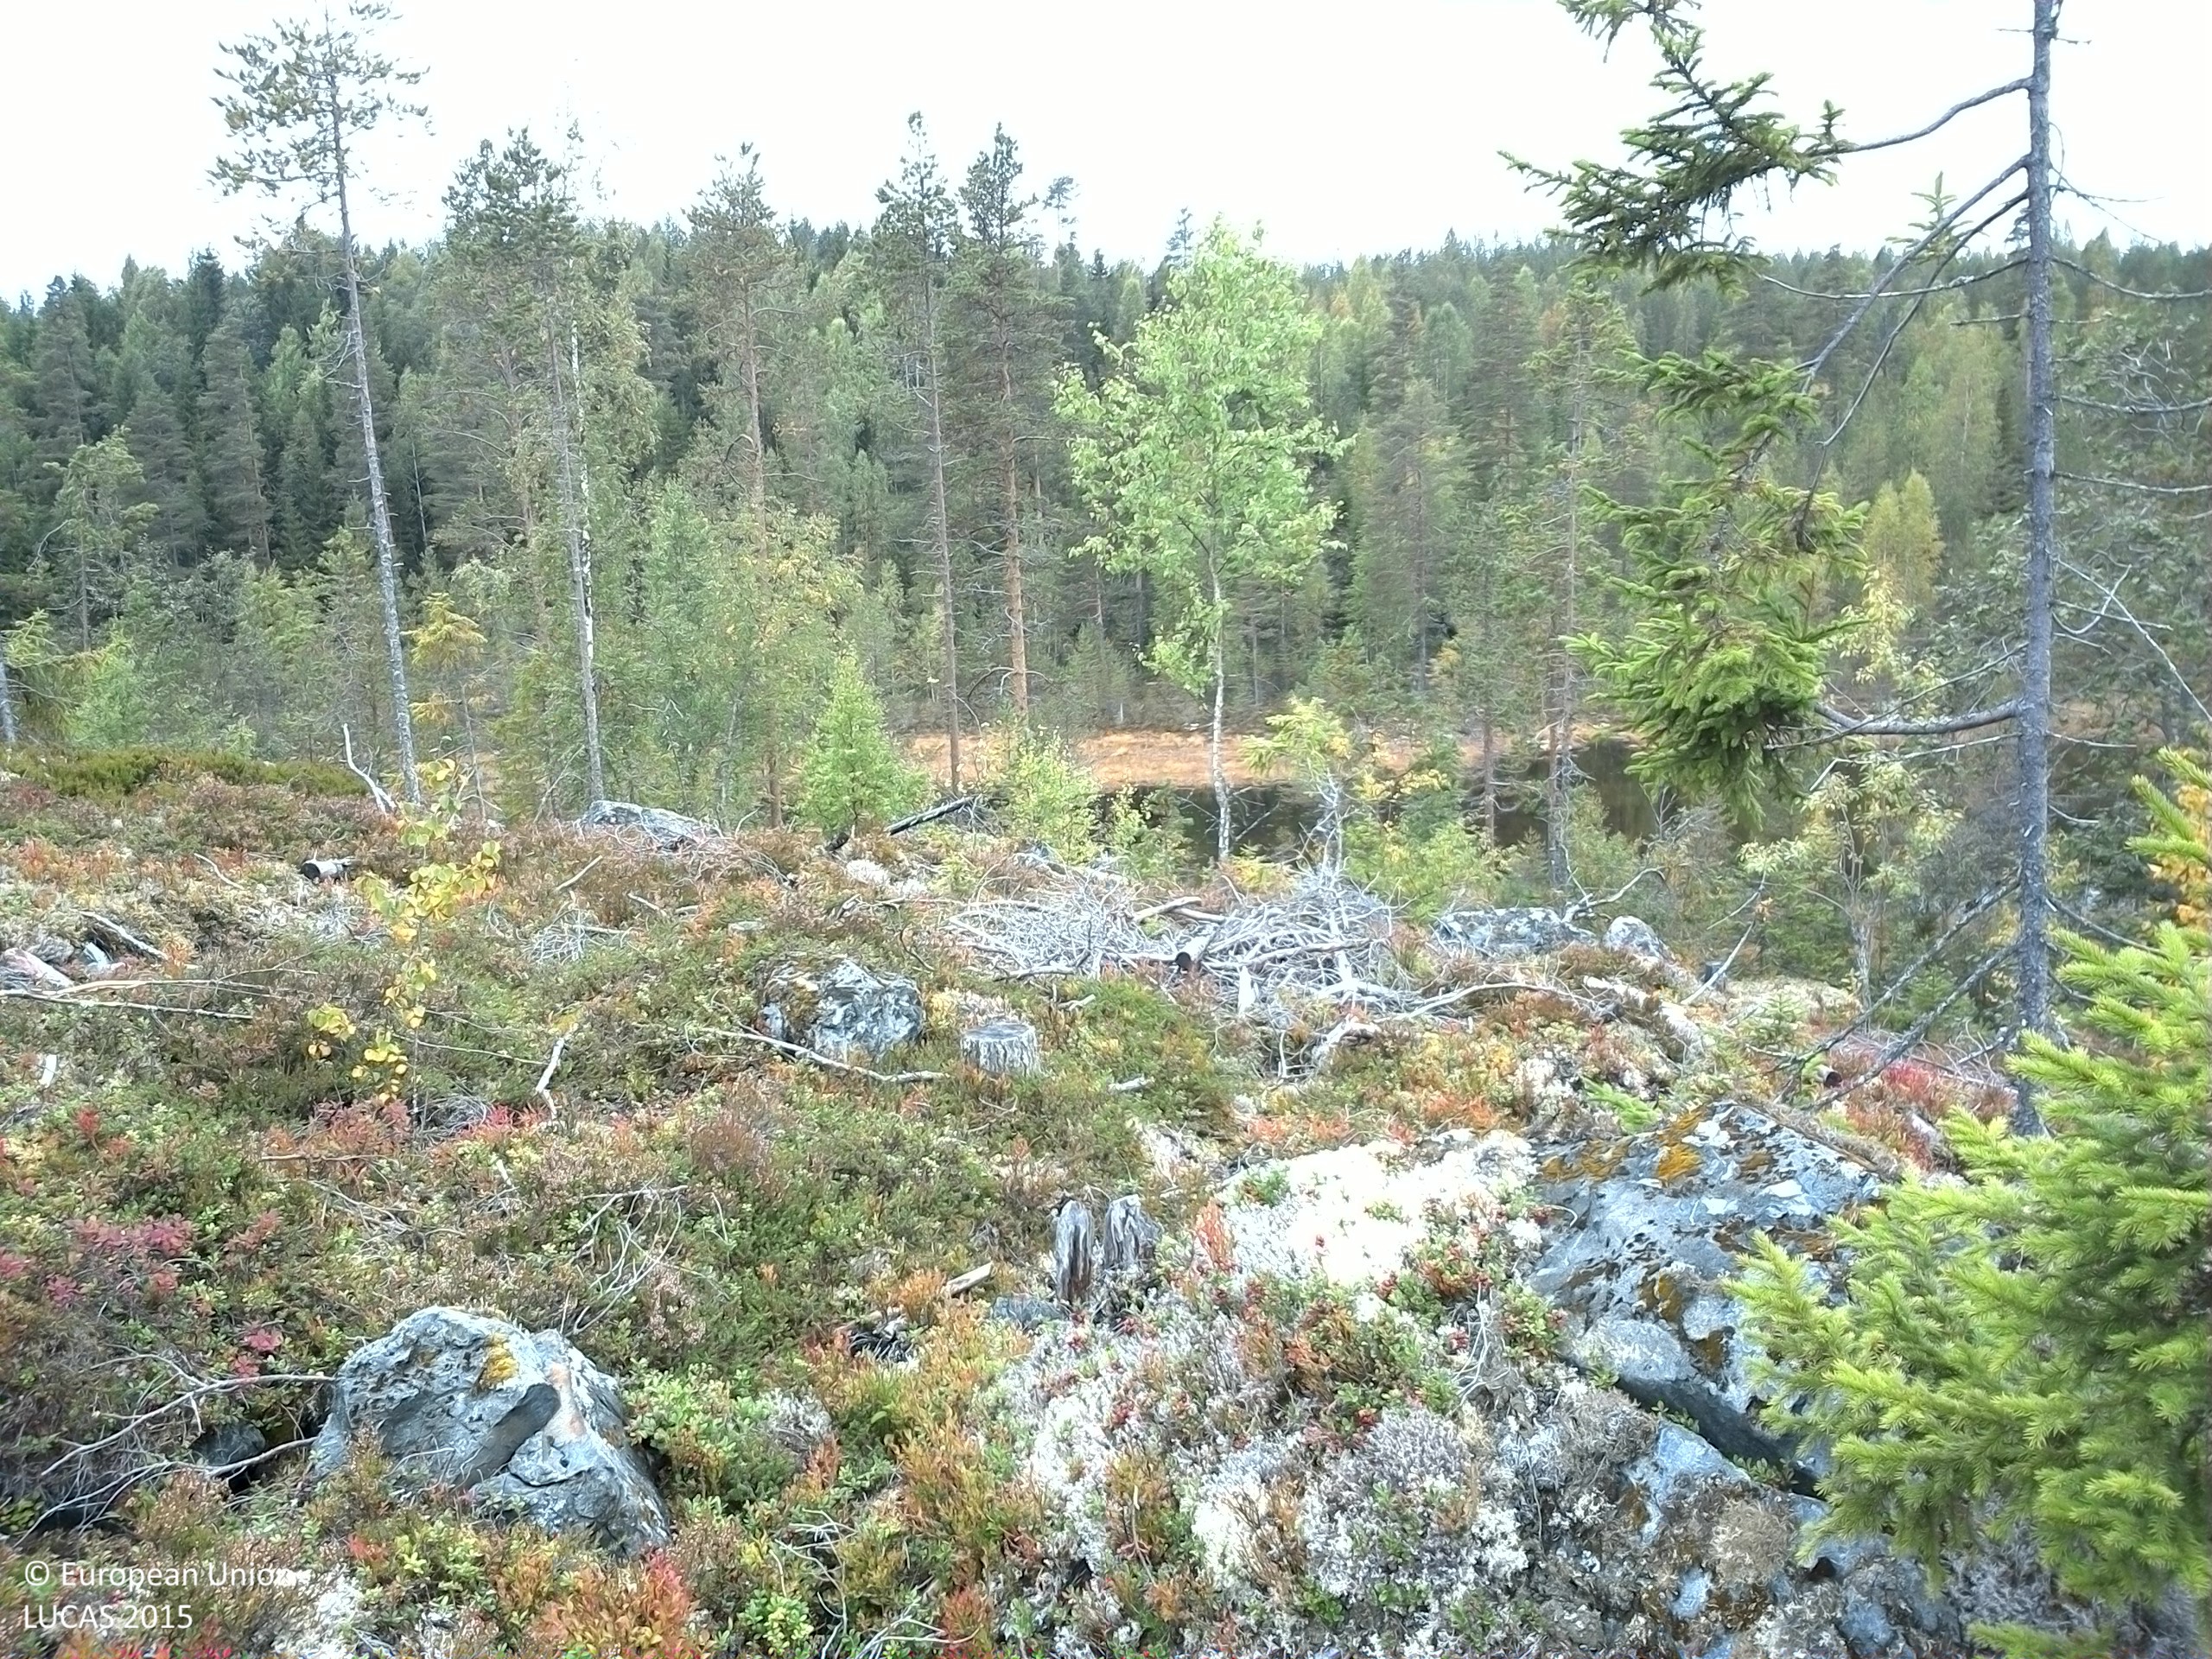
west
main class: Woodland
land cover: Other mixed woodland
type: boreal forest
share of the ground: 10 - 25 %
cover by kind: shrubs 45 %, lichens and mosses 20 %, consolidated bare surface 20 %, broadleaved forest trees 10 %, coniferous forest trees 5 %
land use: Forestry
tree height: < 5 m
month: September
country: SE
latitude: 61.6037
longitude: 15.1297
